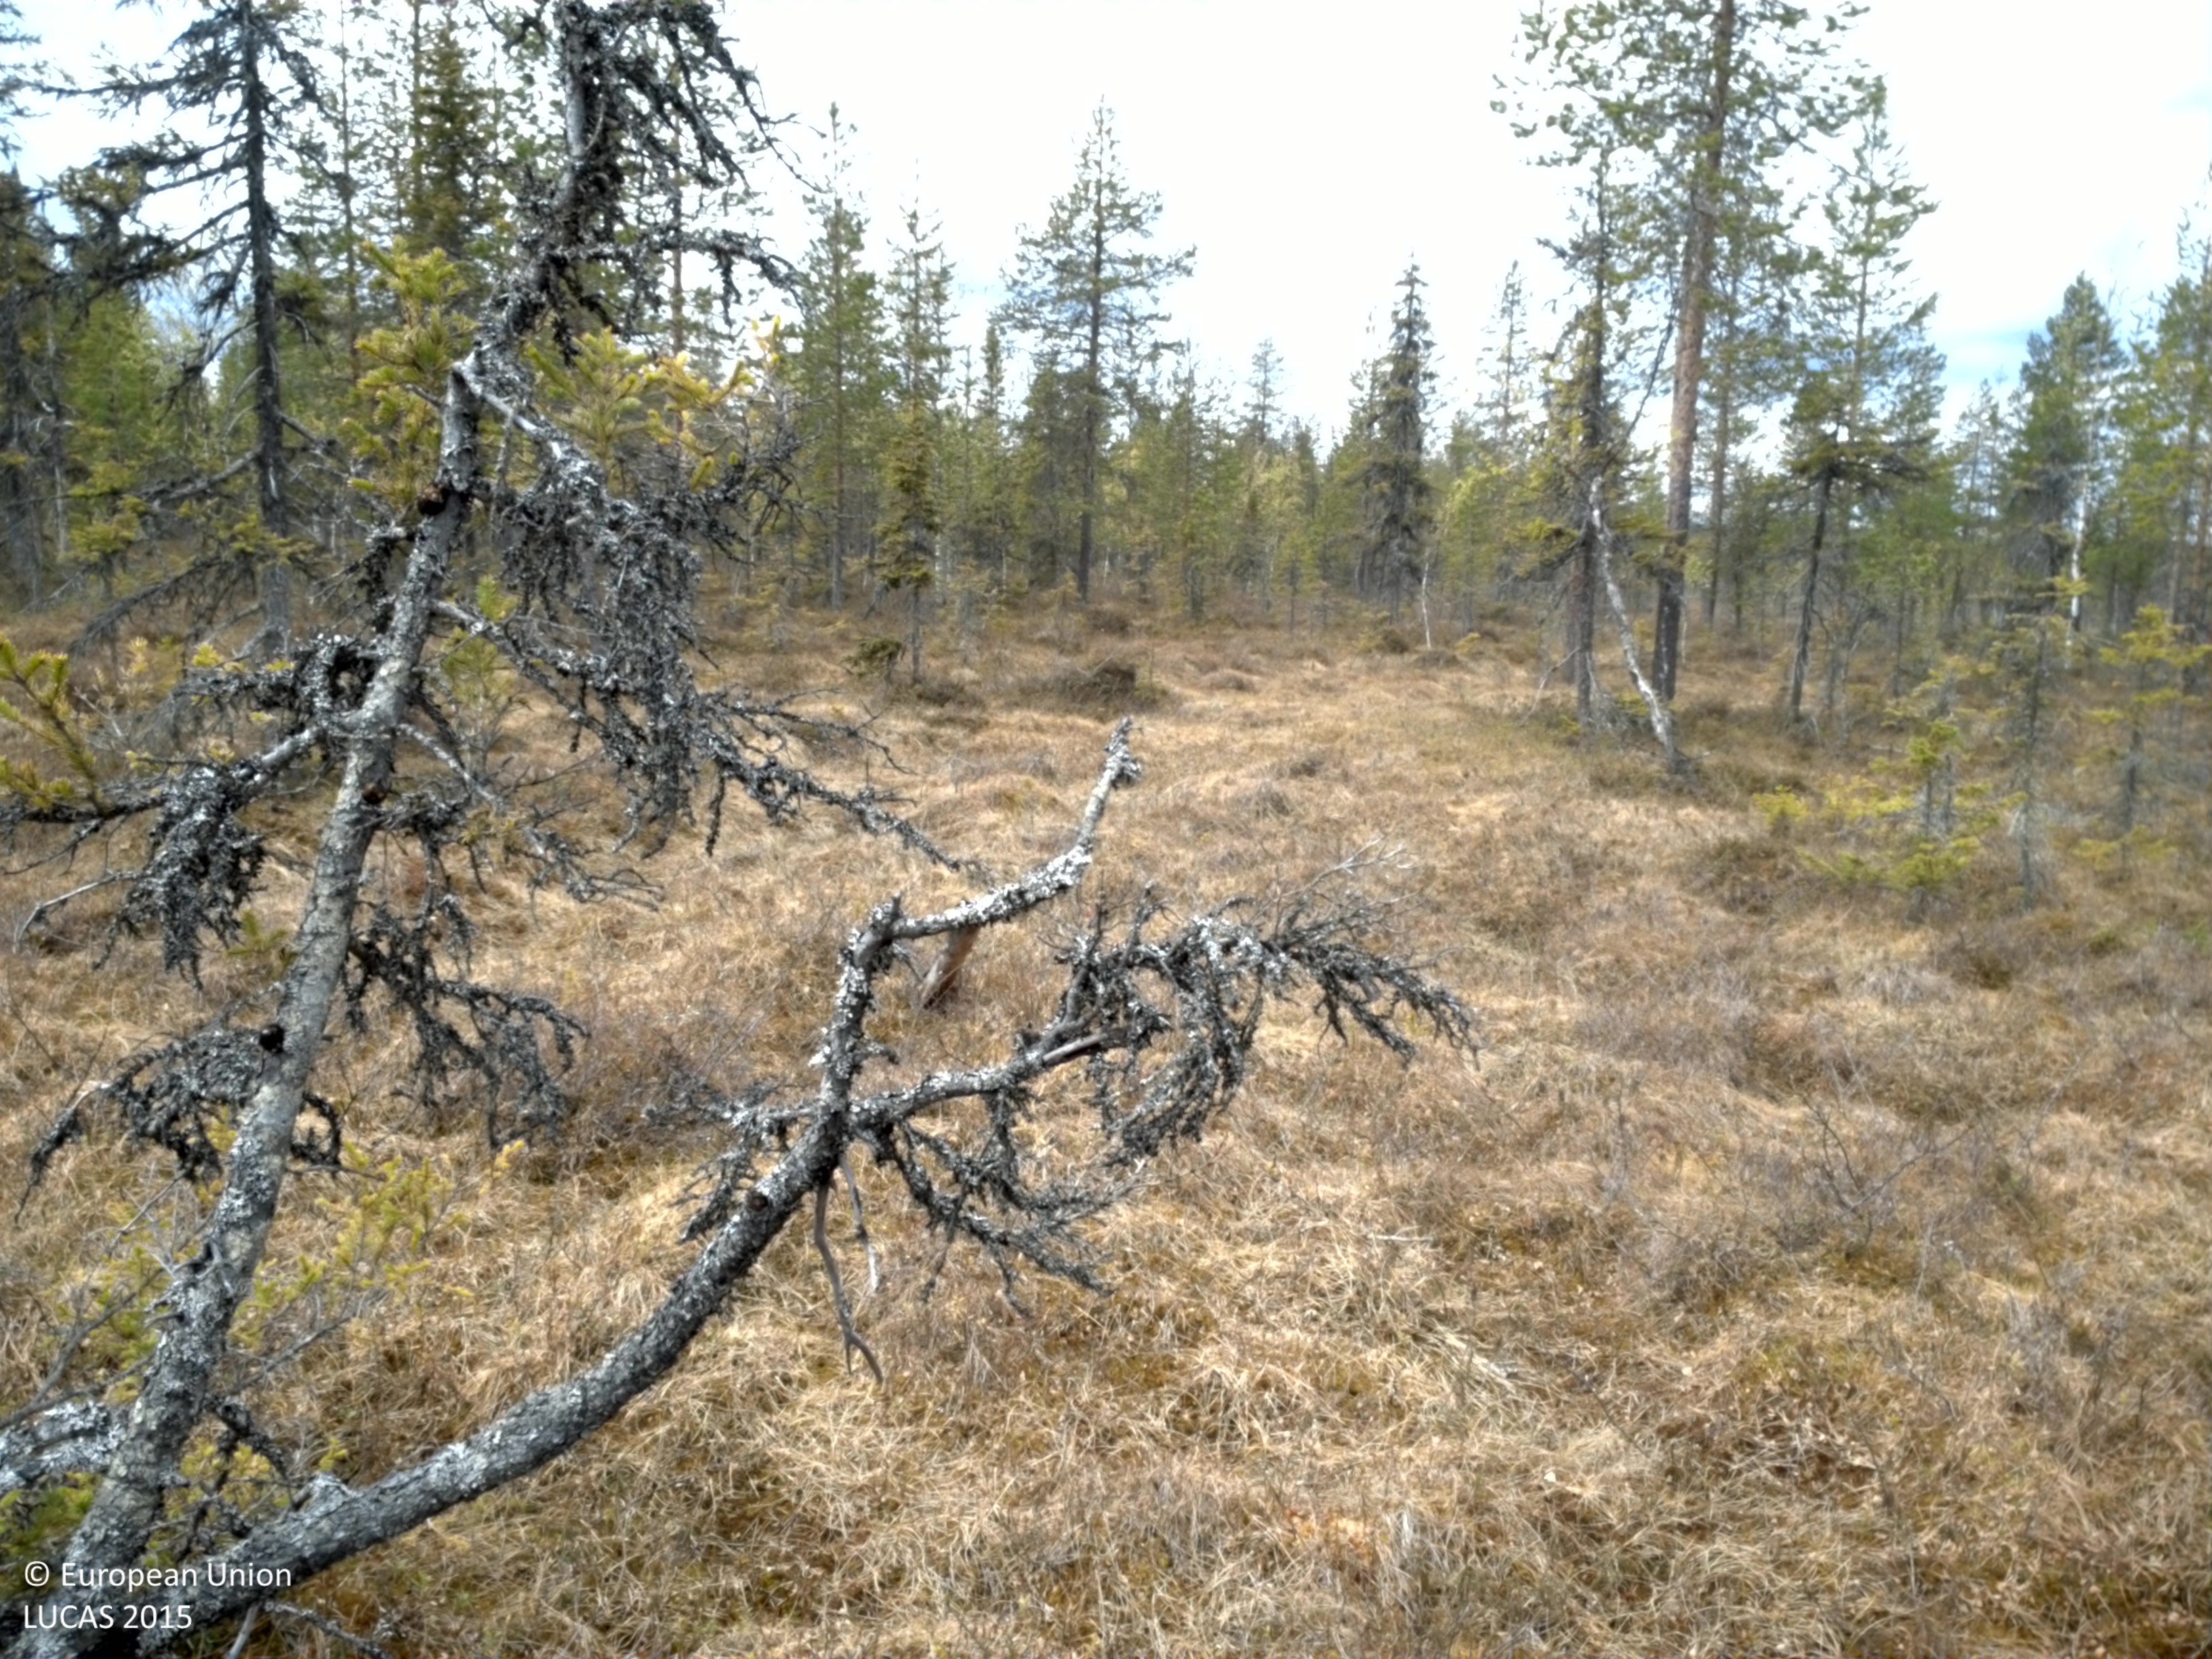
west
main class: Woodland
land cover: Pine dominated coniferous woodland
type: mire and swamp forests
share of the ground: 10 - 25 %
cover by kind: shrubs 50 %, herbaceous plants 35 %, coniferous forest trees 15 %
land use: Semi-natural and natural areas not in use
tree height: > 5 m
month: June
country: SE
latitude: 66.0823
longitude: 18.8192
